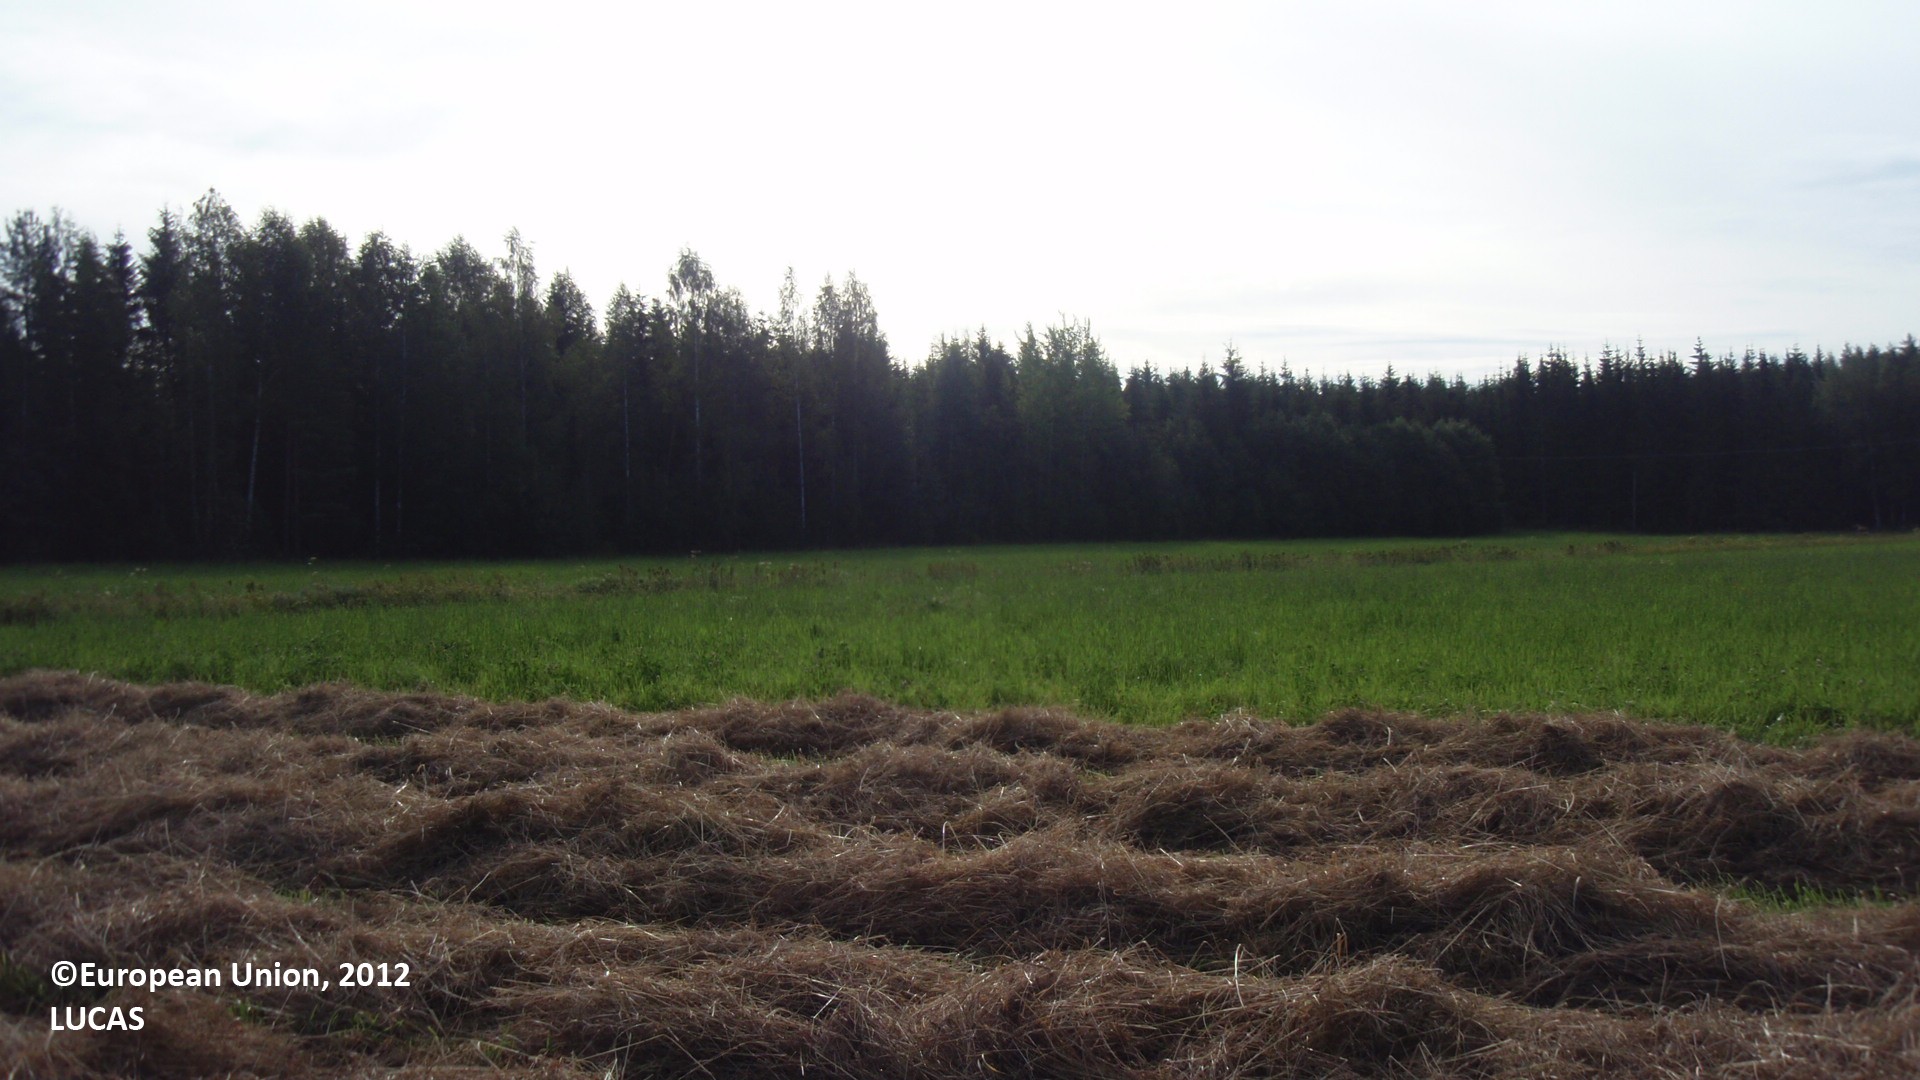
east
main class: Cropland
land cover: Mixed cereals for fodder
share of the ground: > 75 %
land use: Agriculture (excluding fallow land and kitchen gardens)
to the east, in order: Mixed cereals for fodder; Shrubland with sparse tree cover; Ditches and canals; Grassland with sparse tree/shrub cover; Ditches and canals; Grassland with sparse tree/shrub cover; Mixed cereals for fodder; Ditches and canals; Spruce dominated mixed woodland; Spruce dominated coniferous woodland
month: August
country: FI
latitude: 61.2134
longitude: 28.0128
